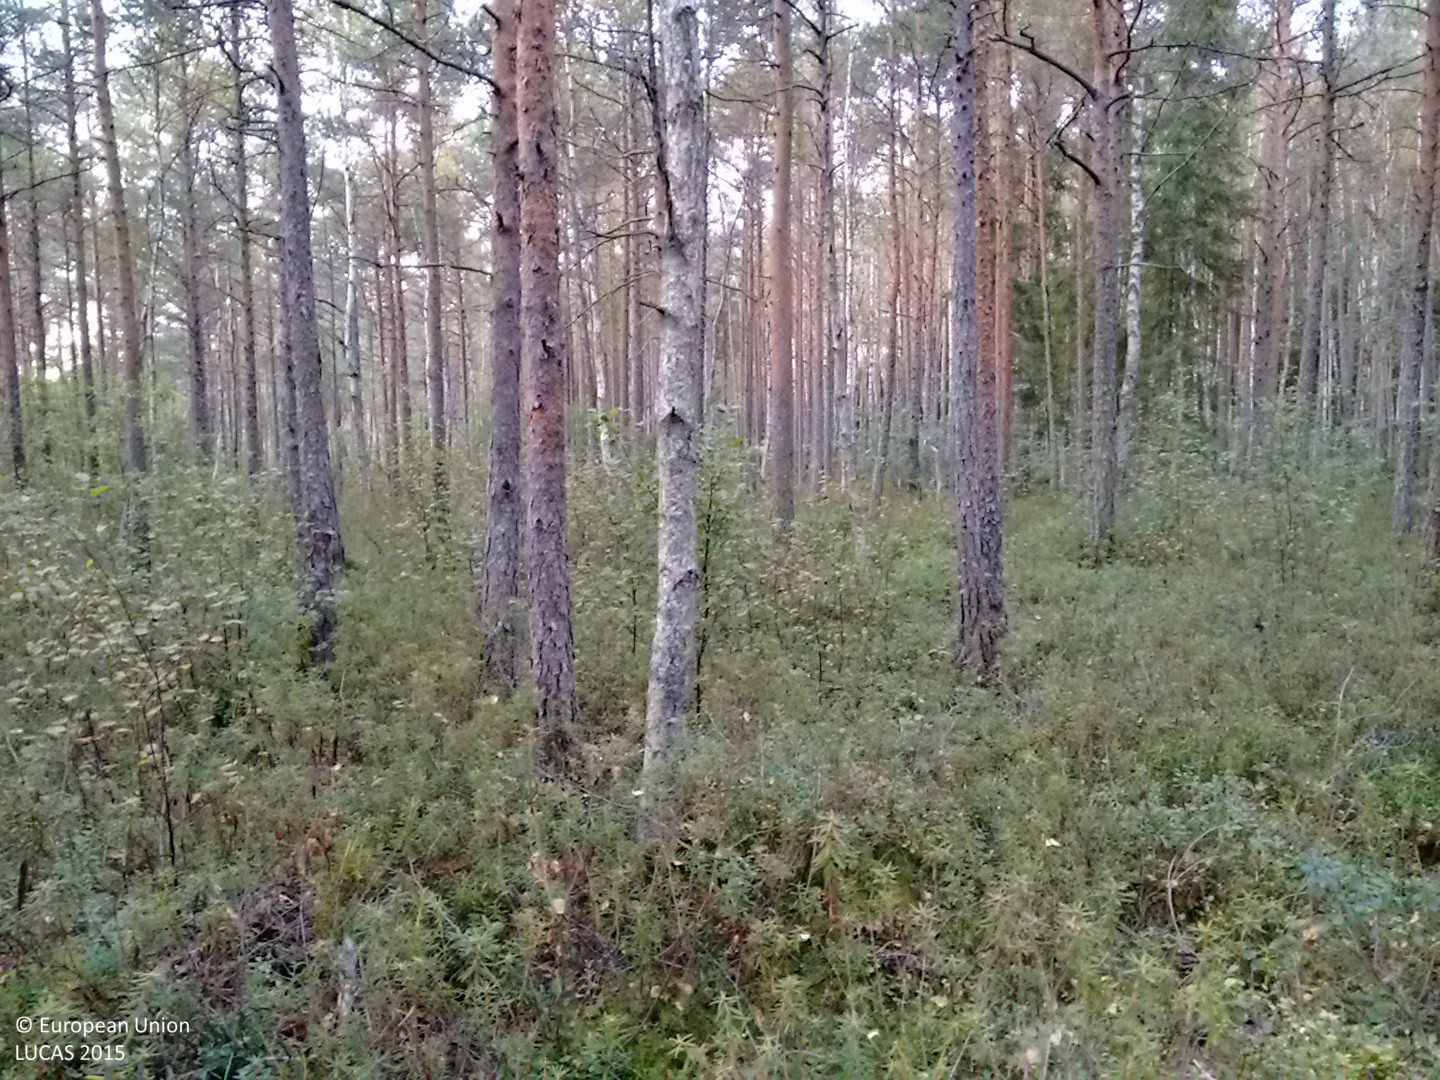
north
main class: Woodland
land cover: Pine dominated mixed woodland
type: hemiboreal forest and nemoral coniferous forest and mixed broadleaved-coniferous forest
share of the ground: > 75 %
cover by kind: coniferous forest trees 60 %, broadleaved forest trees 20 %, shrubs 20 %
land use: Forestry
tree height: > 5 m
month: September
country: FI
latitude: 60.9407
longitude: 21.5904
